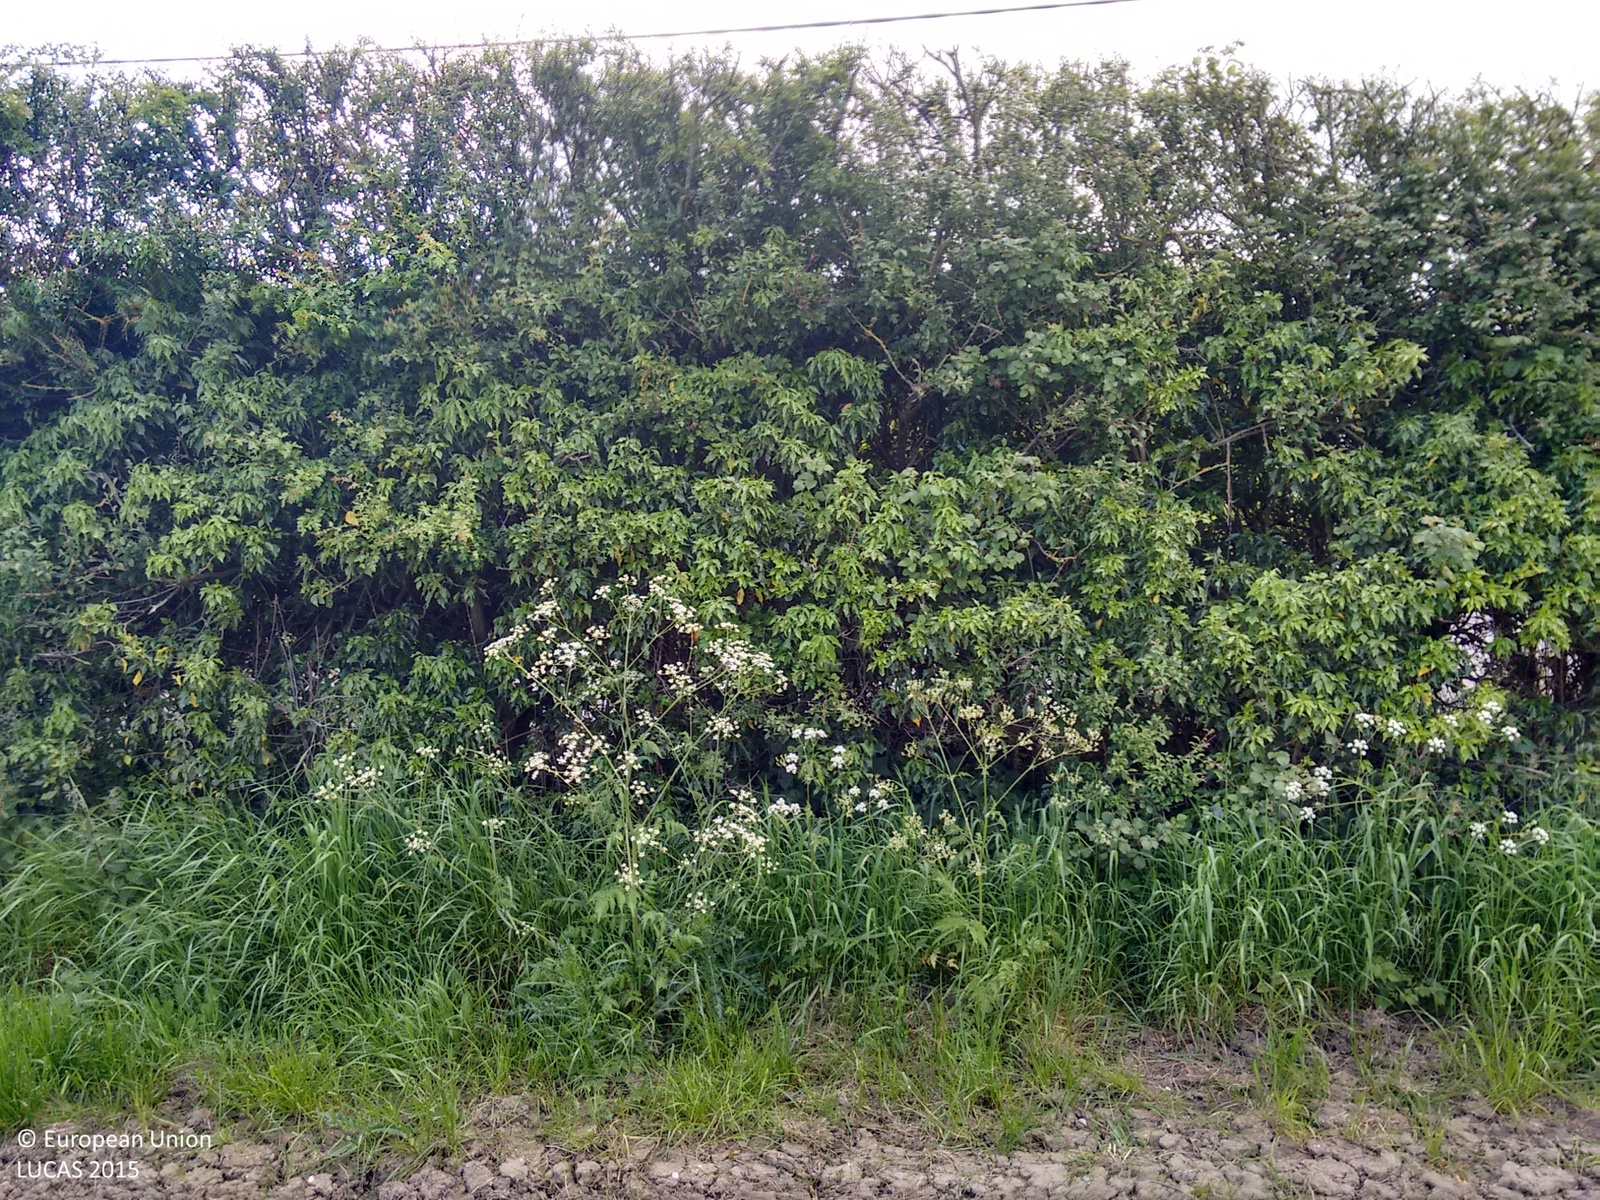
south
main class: Cropland
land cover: Common wheat
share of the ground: > 75 %
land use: Agriculture (excluding fallow land and kitchen gardens)
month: June
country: GB
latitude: 53.9057
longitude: -1.1101
